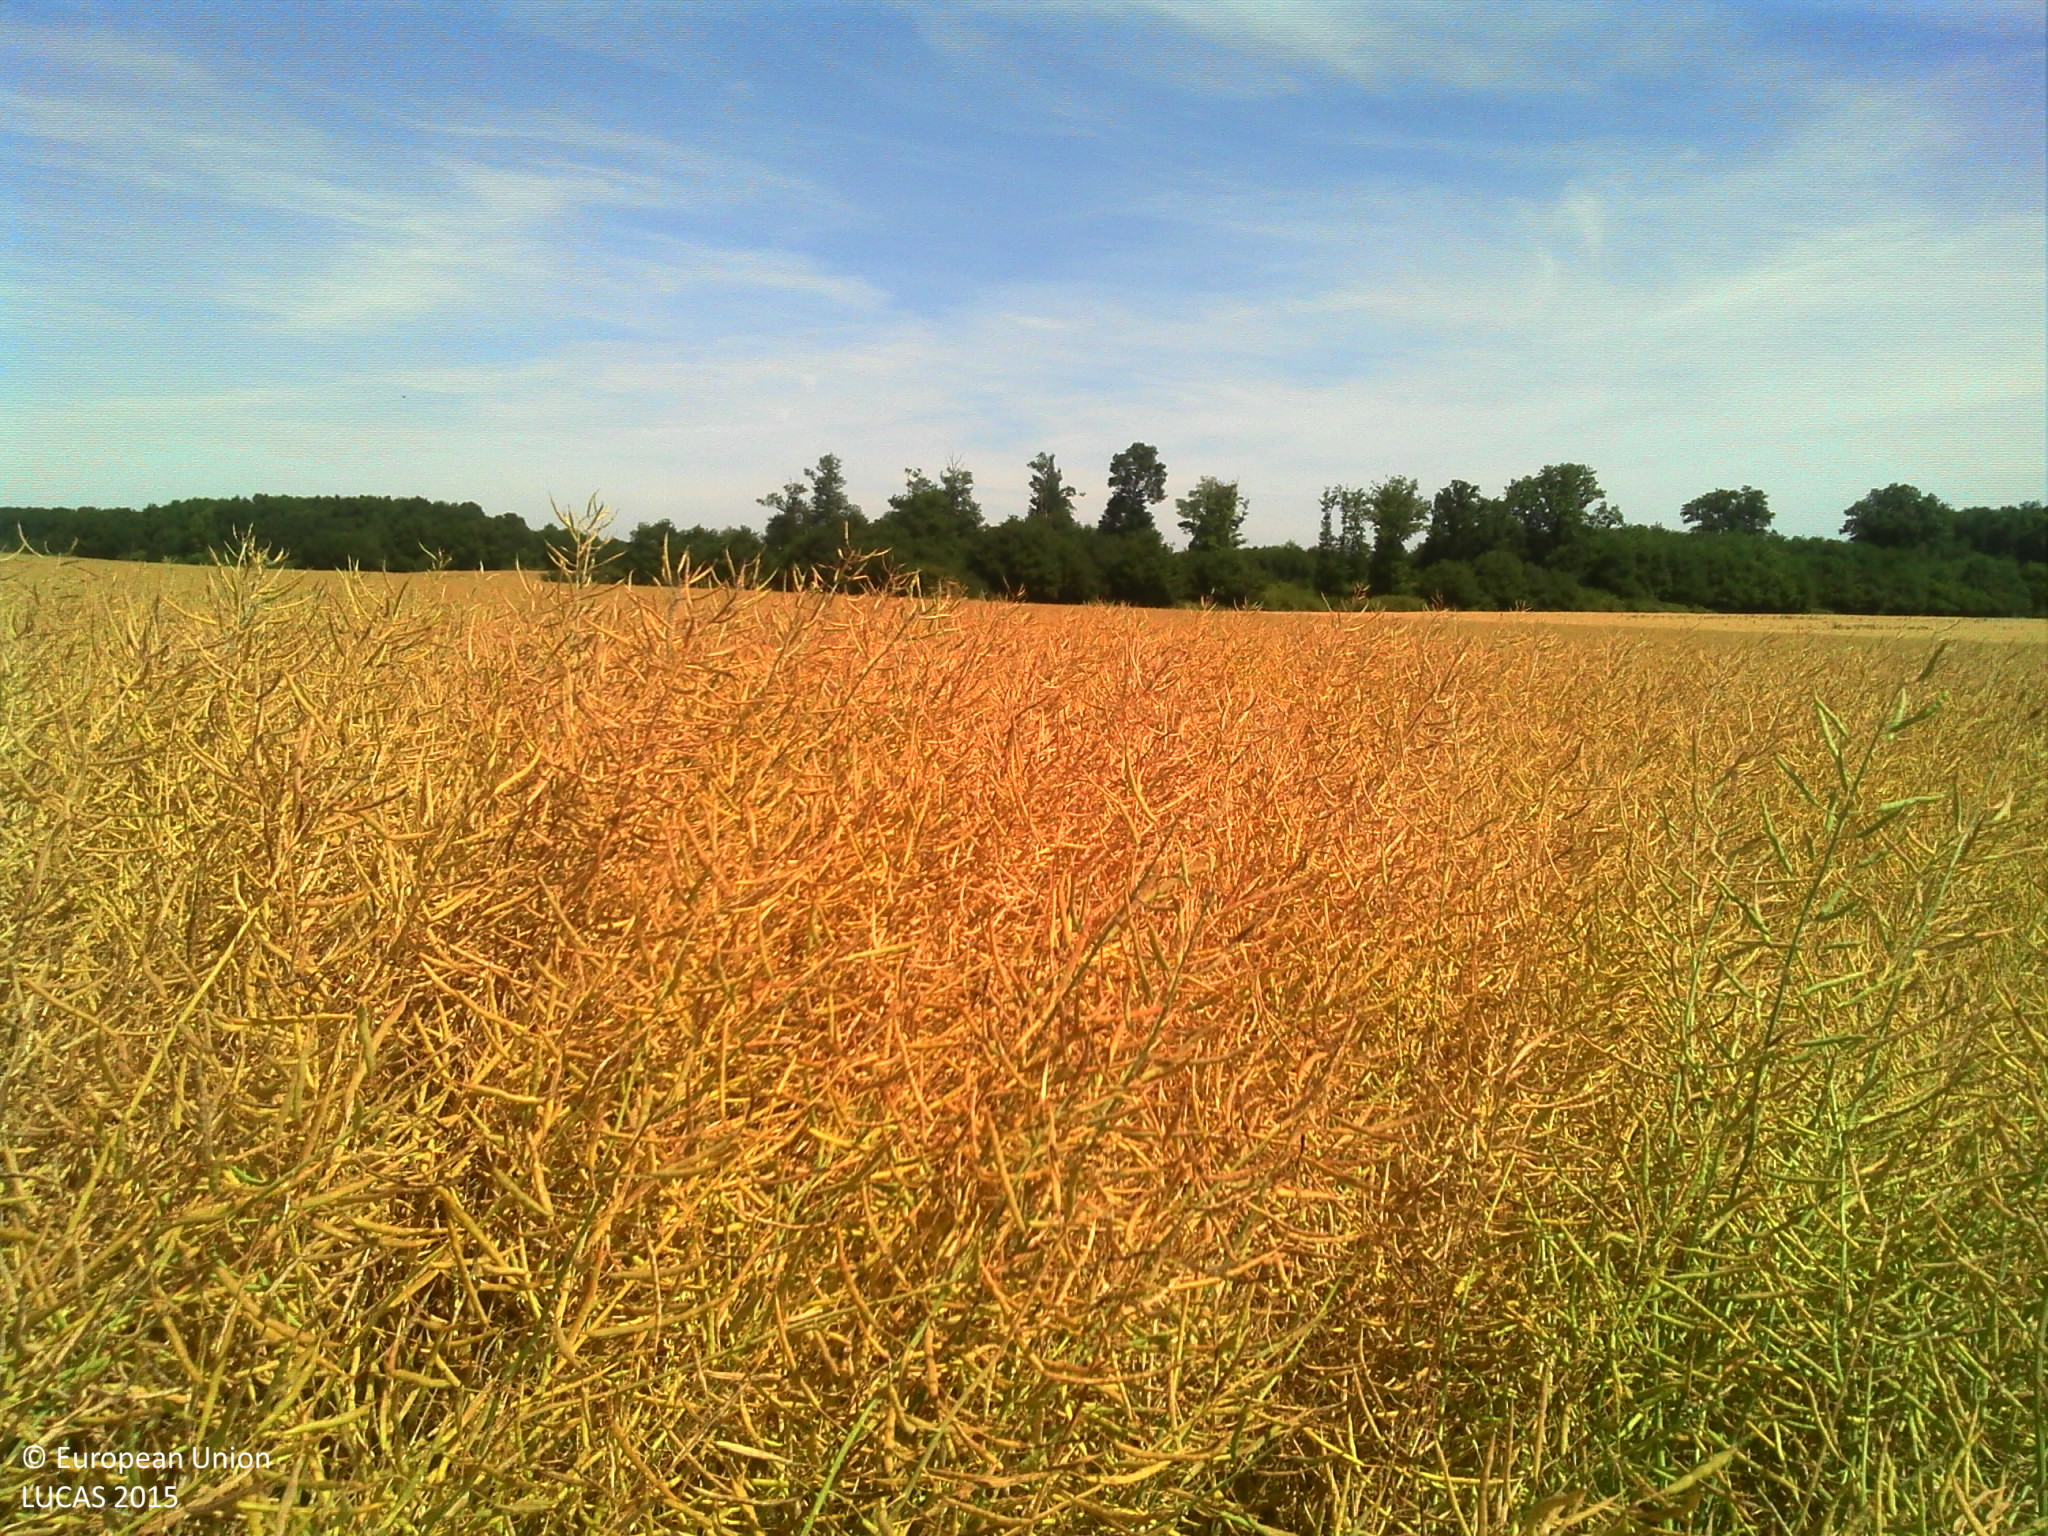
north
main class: Cropland
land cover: Rape and turnip rape
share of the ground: > 75 %
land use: Agriculture (excluding fallow land and kitchen gardens)
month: June
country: FR
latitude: 48.6313
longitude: 1.2017
